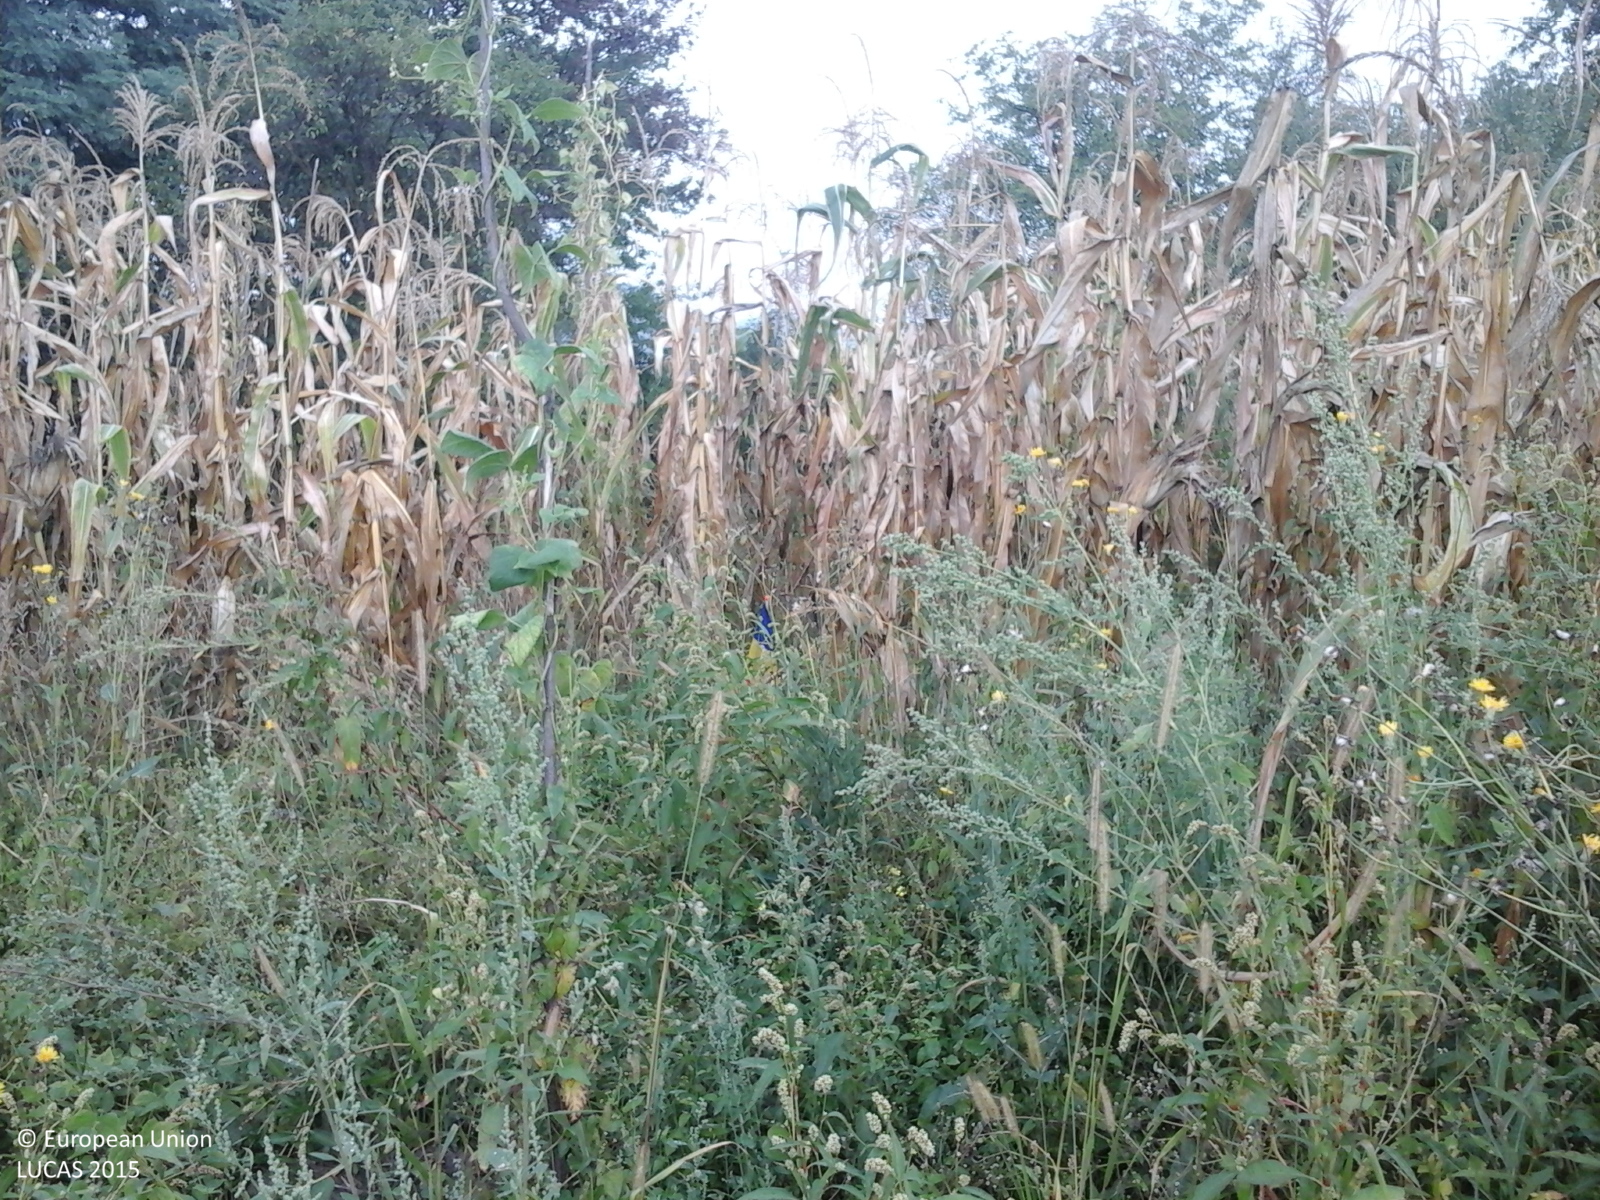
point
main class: Cropland
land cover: Maize
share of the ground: 50 - 75 %
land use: Agriculture (excluding fallow land and kitchen gardens)
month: September
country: RO
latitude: 47.8822
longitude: 23.9243
